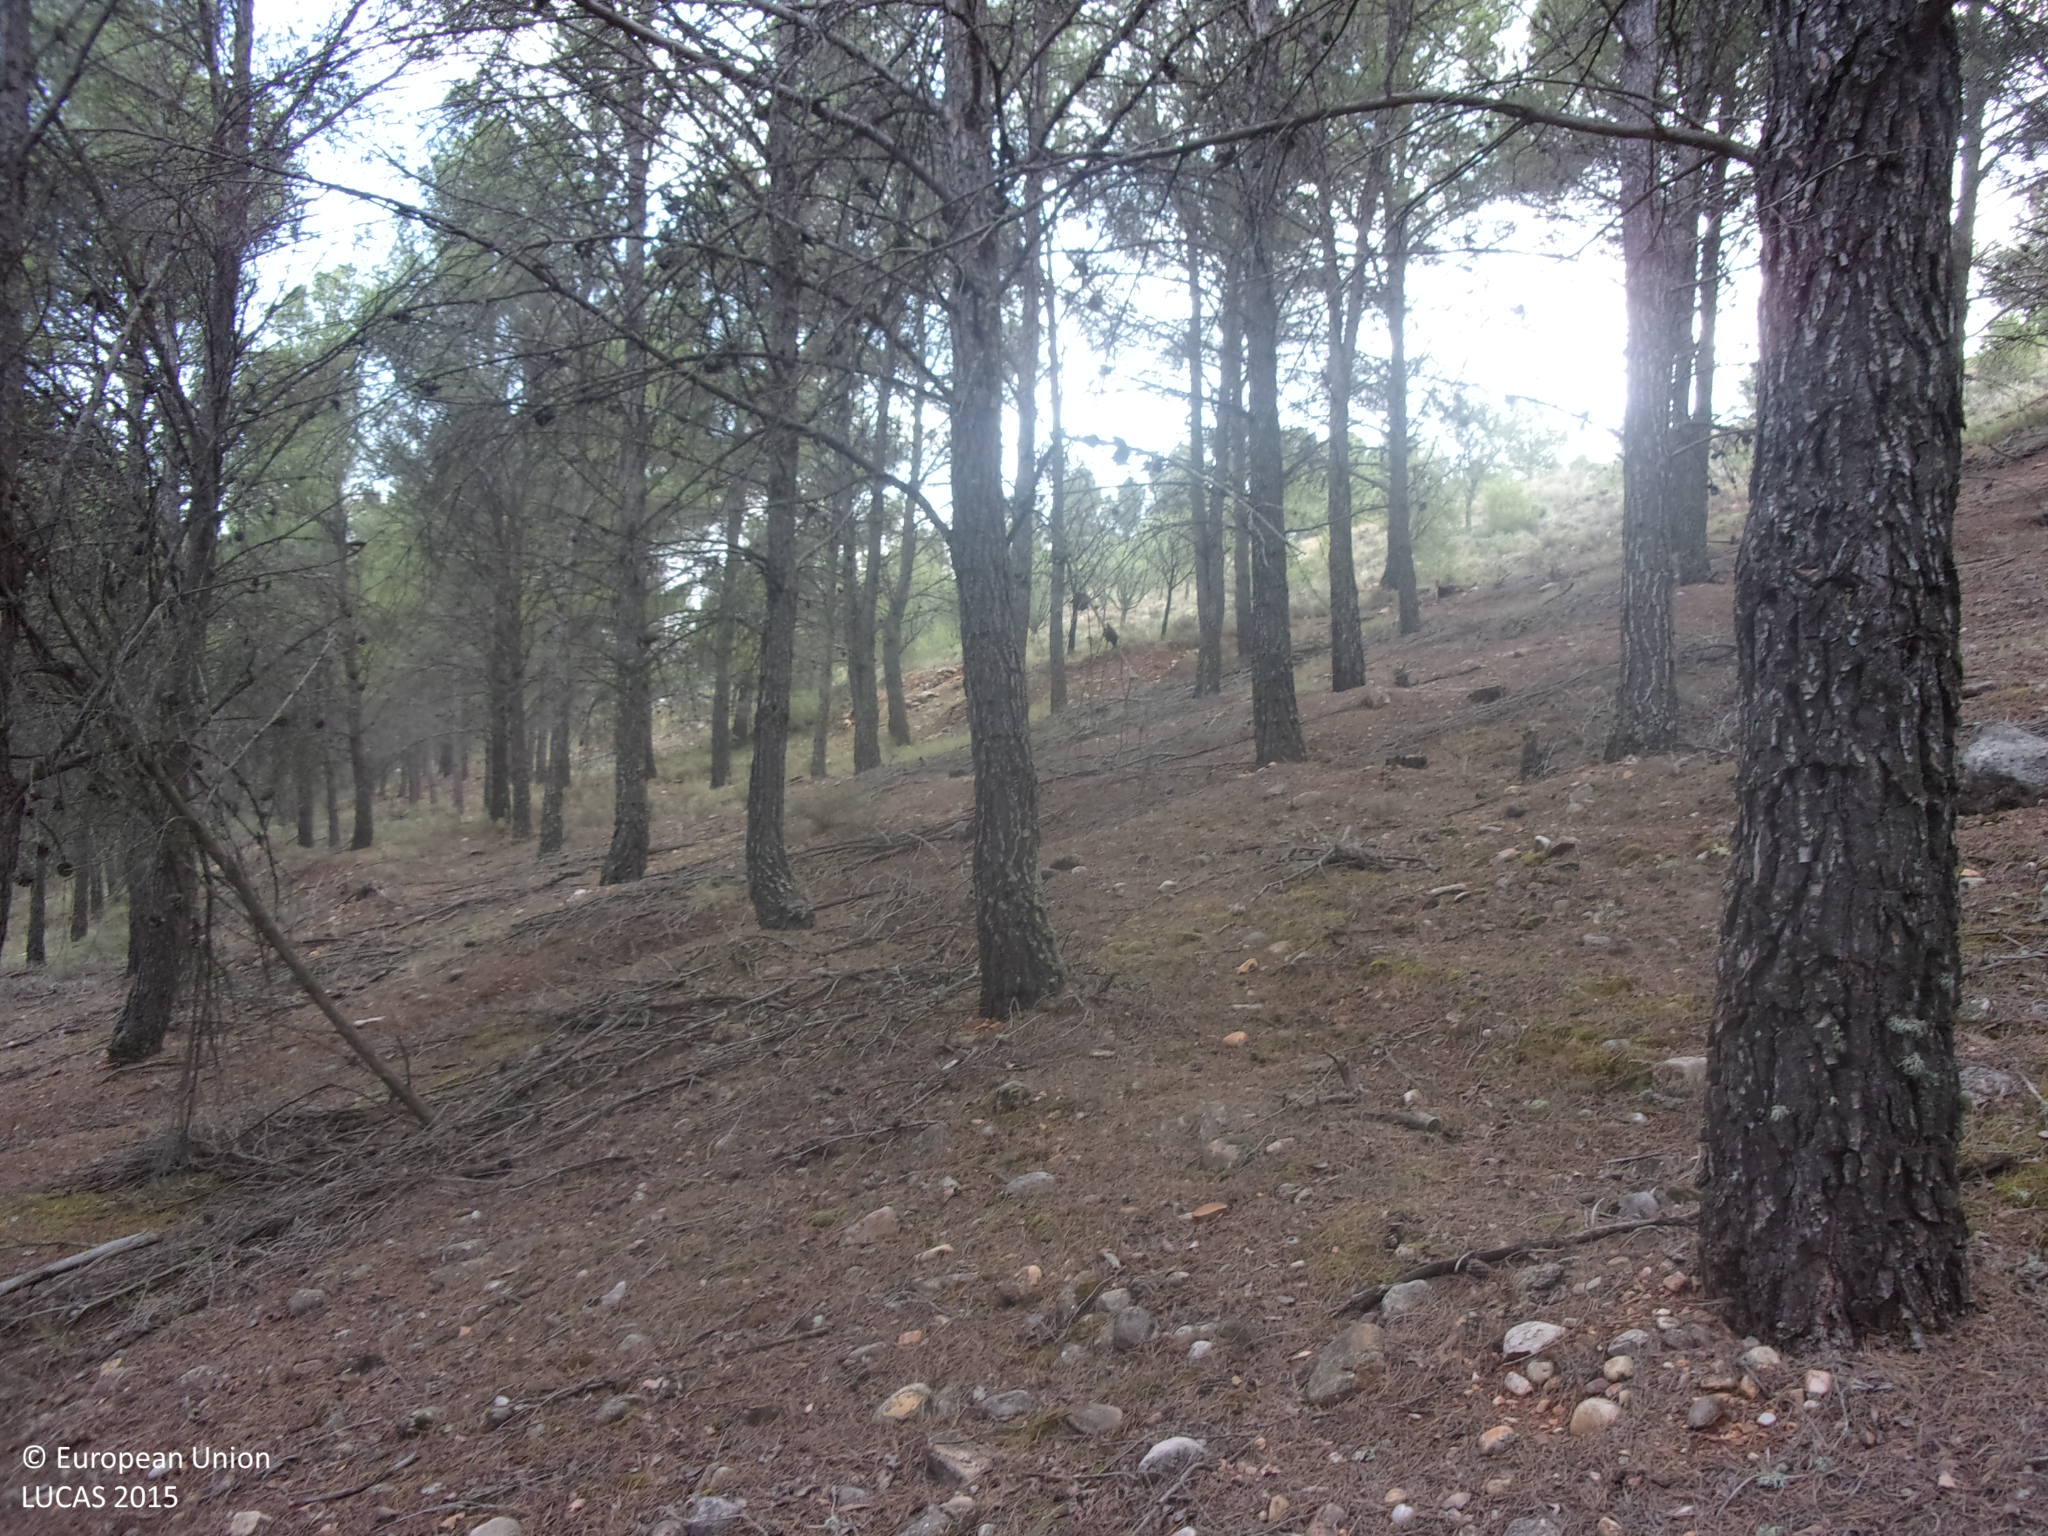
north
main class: Woodland
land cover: Pine dominated coniferous woodland
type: coniferous forest of the mediterranean region
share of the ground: > 75 %
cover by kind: coniferous forest trees 85 %, herbaceous plants 15 %
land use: Forestry
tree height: < 5 m
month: July
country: ES
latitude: 41.1907
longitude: -1.8411
